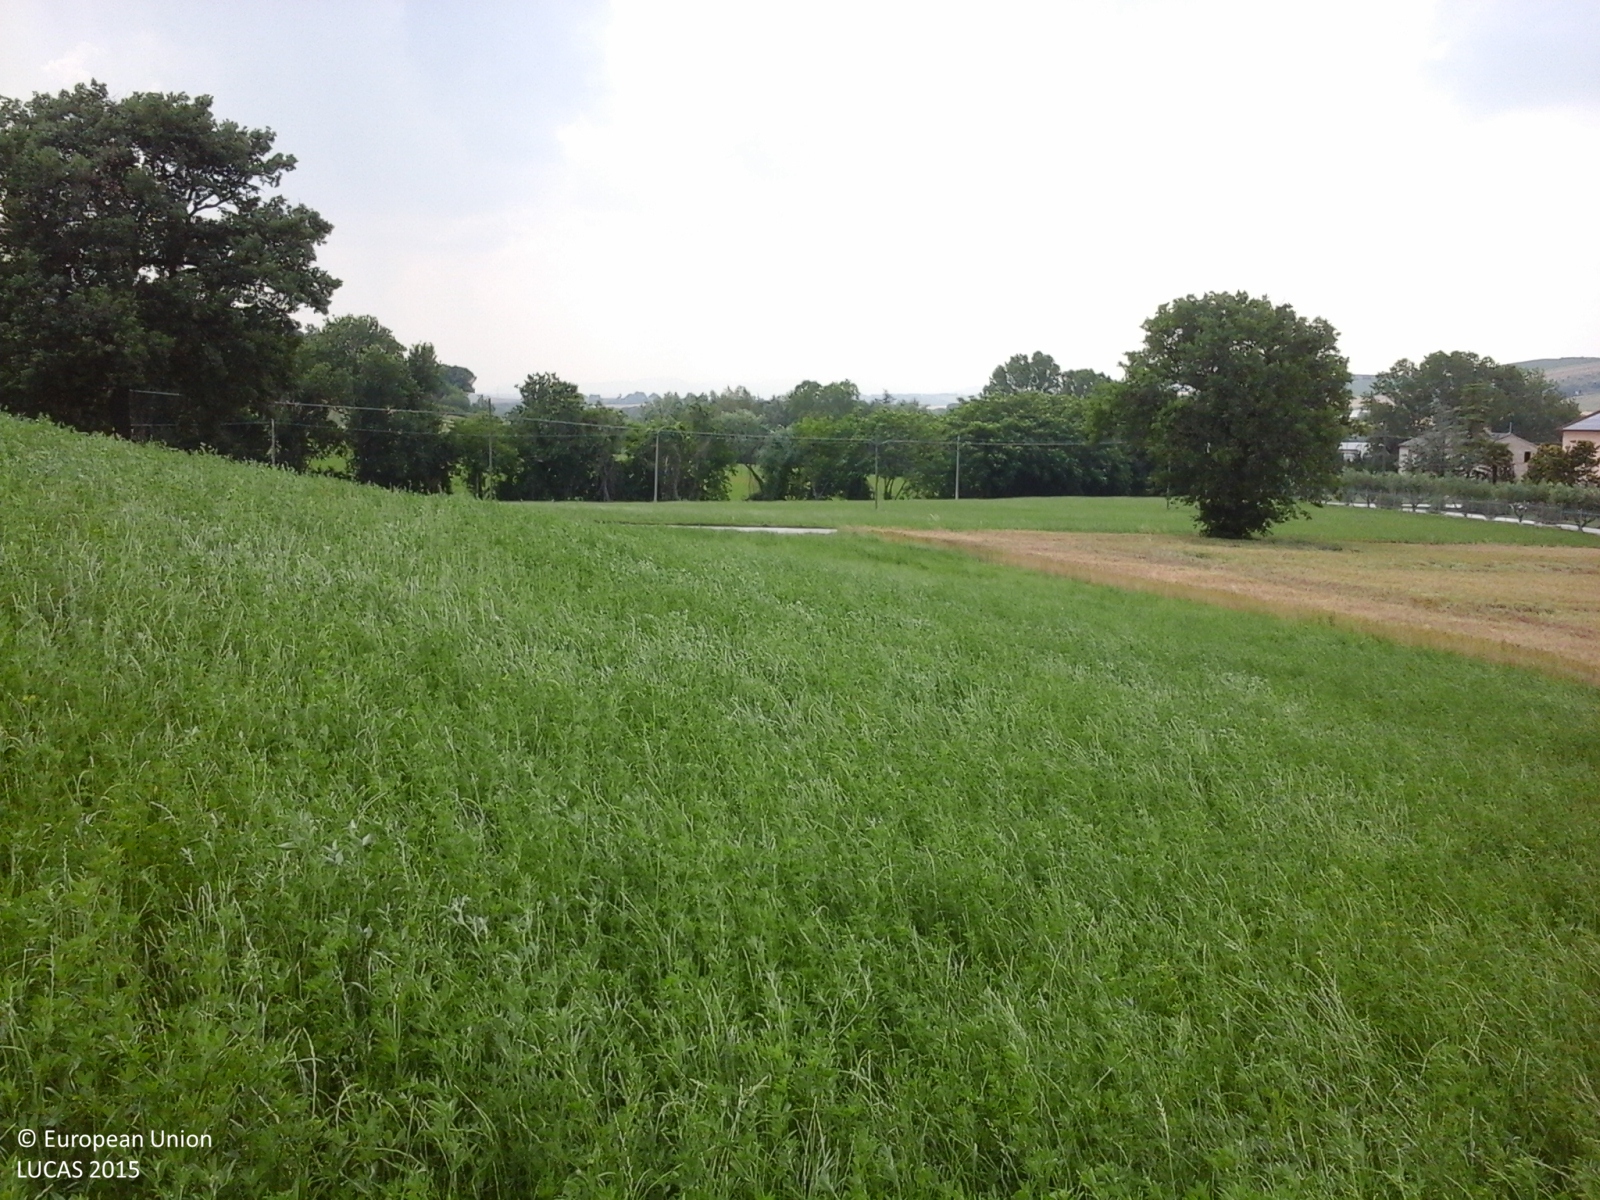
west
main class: Cropland
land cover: Lucerne
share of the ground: > 75 %
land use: Agriculture (excluding fallow land and kitchen gardens)
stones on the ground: > 50 %
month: June
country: IT
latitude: 43.2277
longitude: 13.4507
